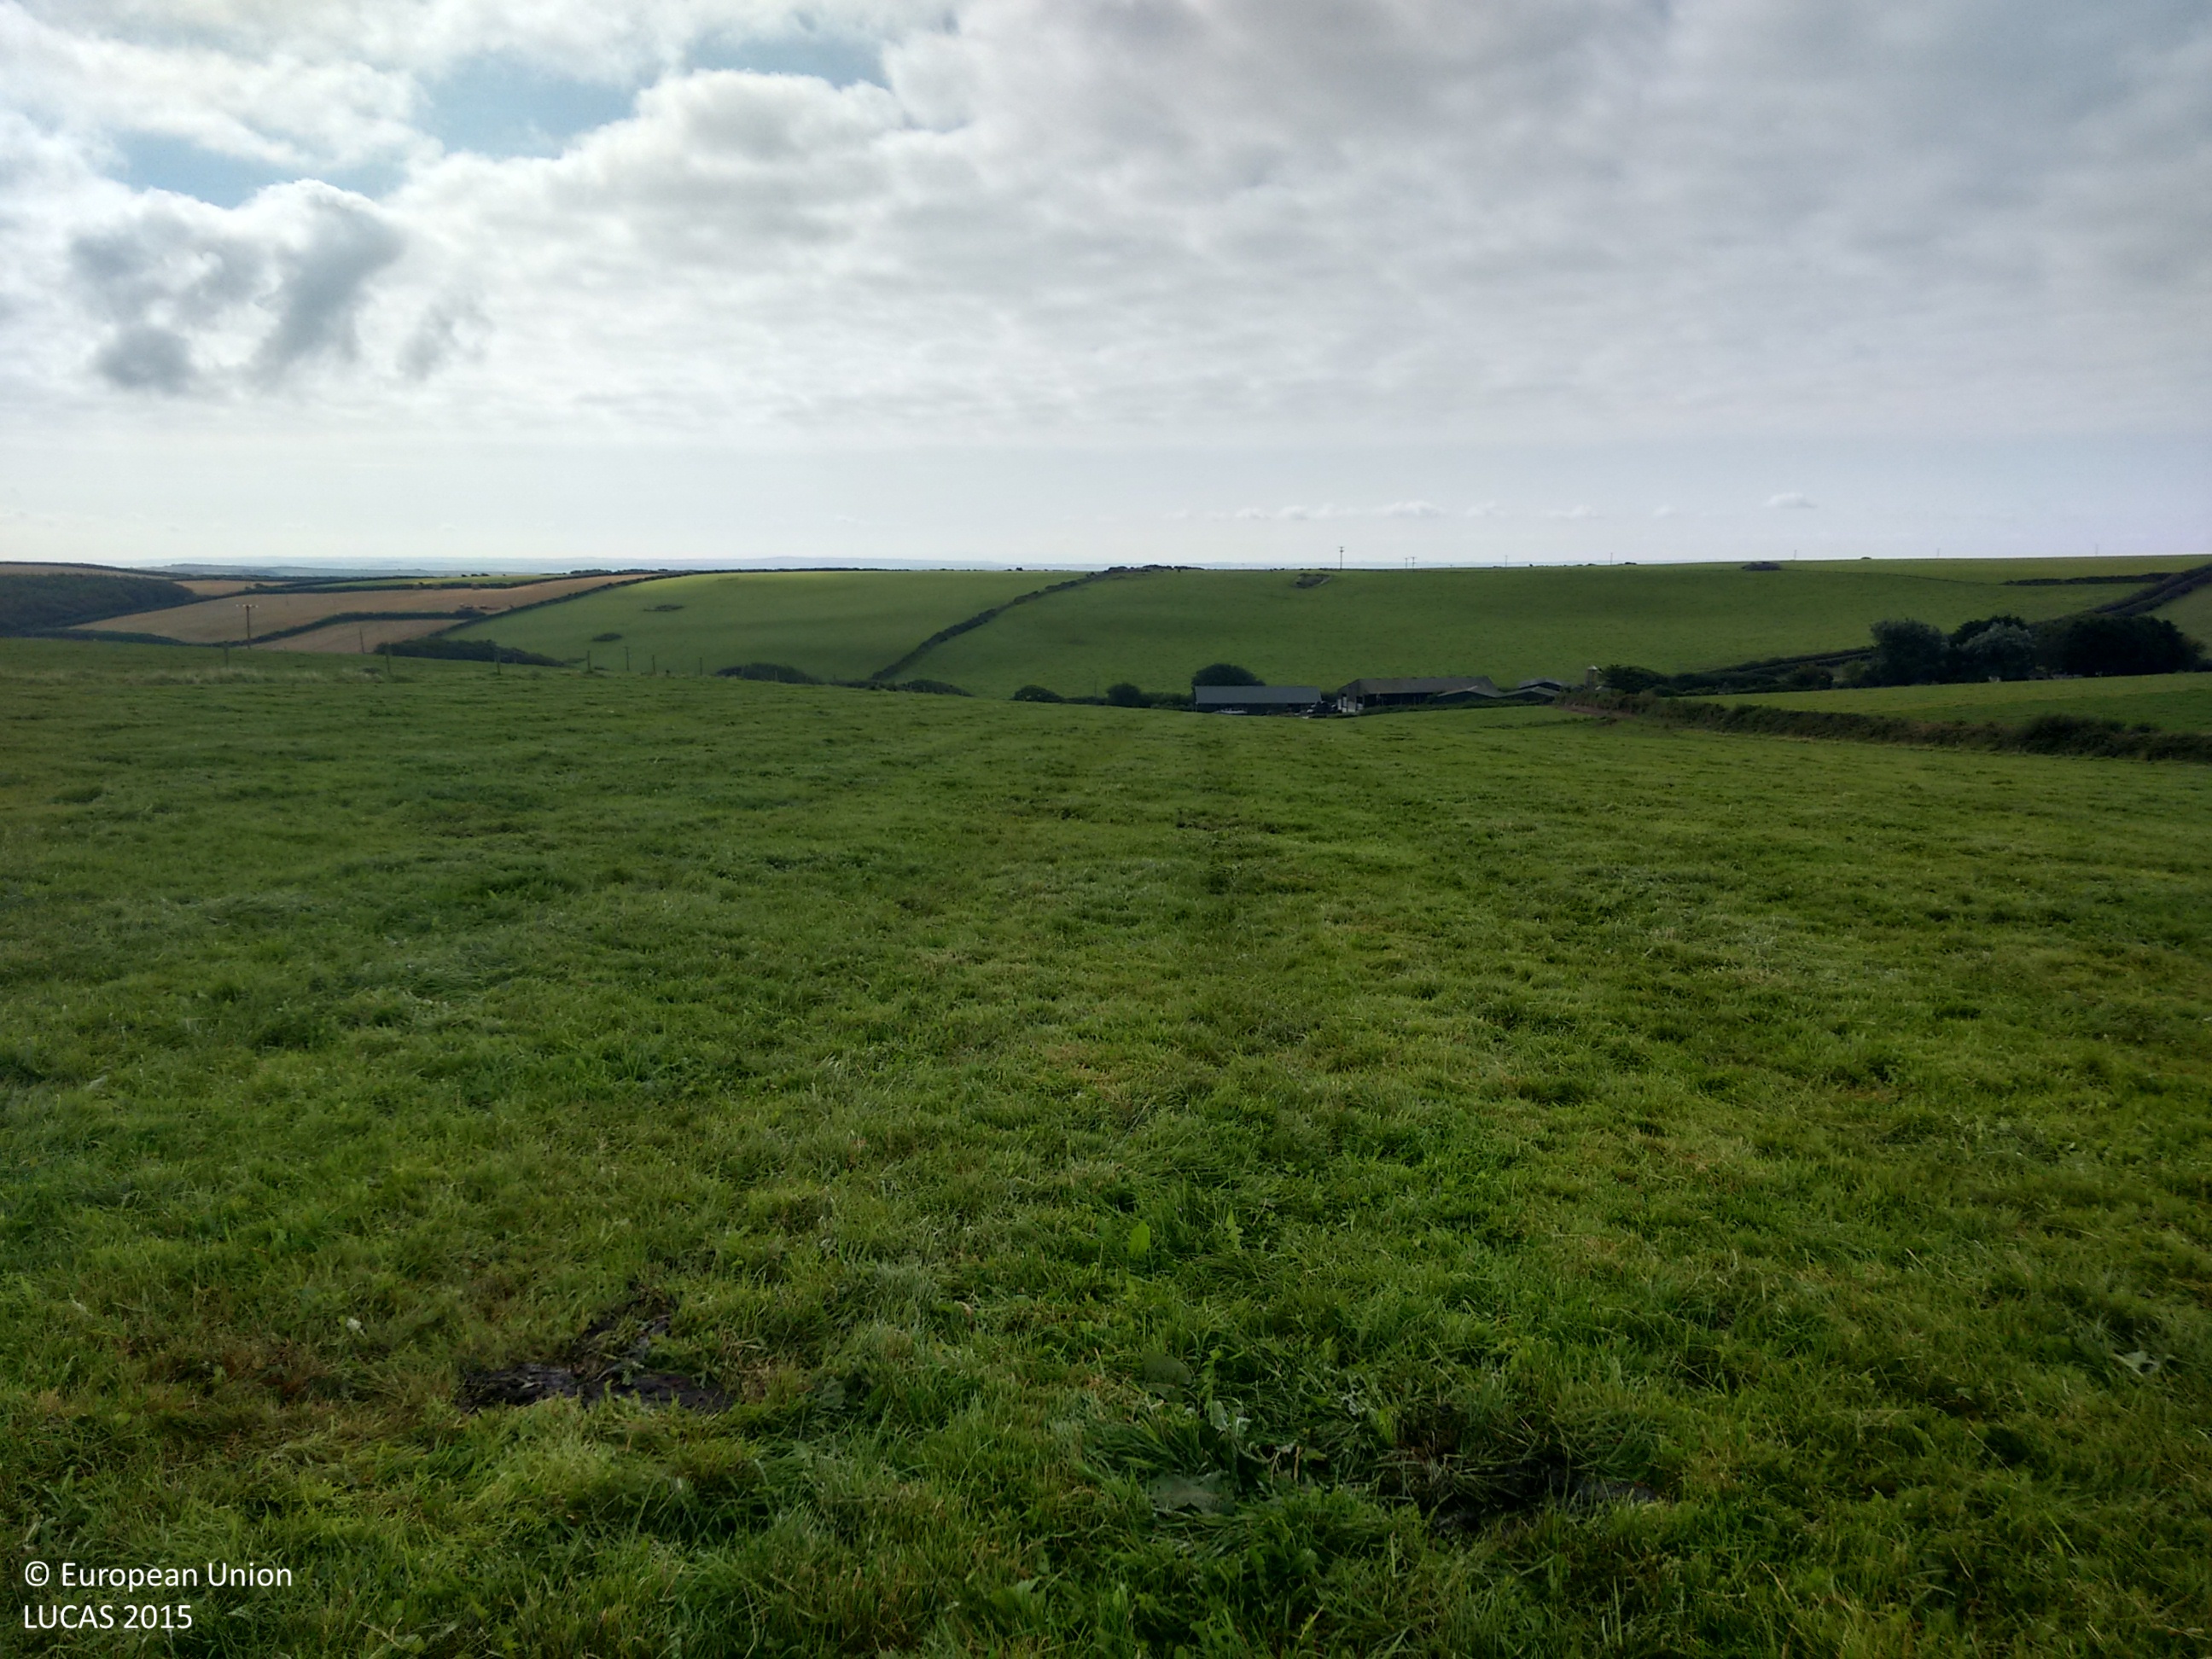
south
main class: Grassland
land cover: Grassland without tree/shrub cover
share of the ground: > 75 %
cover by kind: herbaceous plants 100 %
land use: Agriculture (excluding fallow land and kitchen gardens)
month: September
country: GB
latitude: 51.1549
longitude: -4.1812
